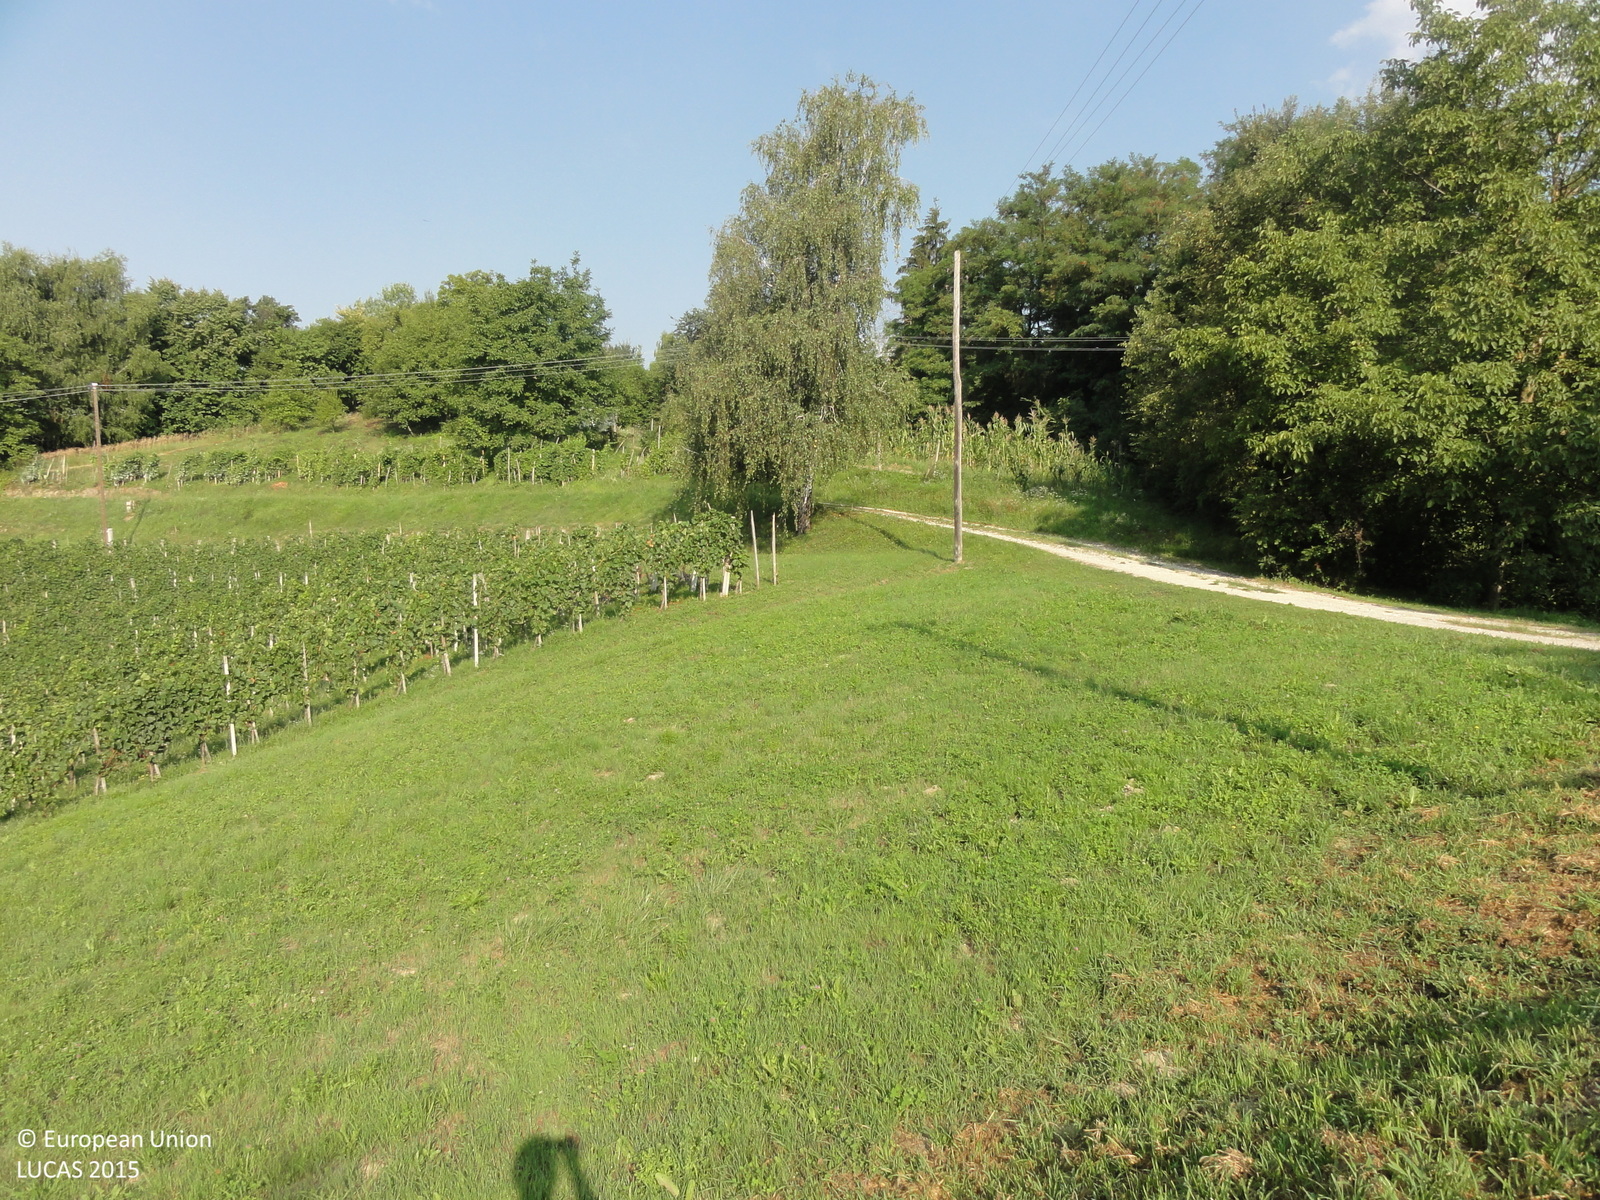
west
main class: Grassland
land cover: Grassland without tree/shrub cover
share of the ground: > 75 %
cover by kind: herbaceous plants 100 %
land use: Agriculture (excluding fallow land and kitchen gardens)
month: August
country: SI
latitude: 46.0024
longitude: 15.6666
